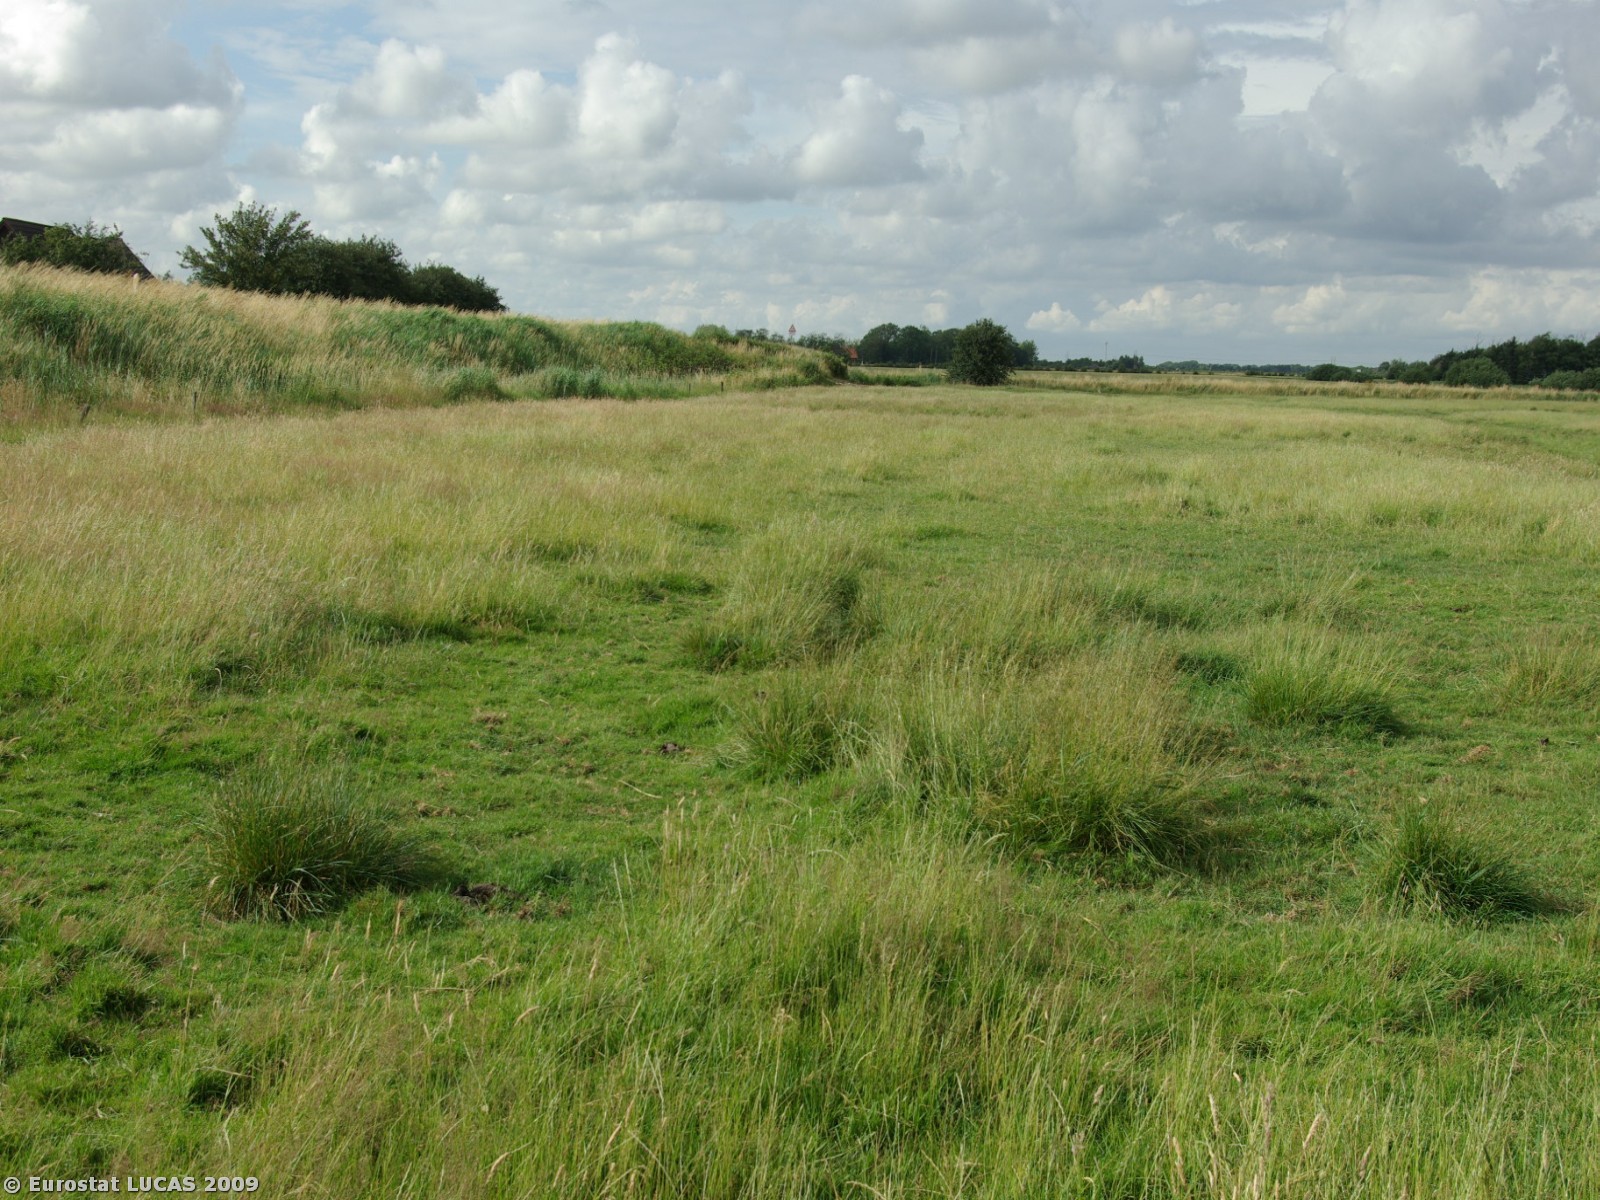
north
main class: Grassland
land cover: Grassland without tree/shrub cover
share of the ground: > 75 %
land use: Agriculture (excluding fallow land and kitchen gardens)
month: July
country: DK
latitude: 54.9247
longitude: 8.8930
